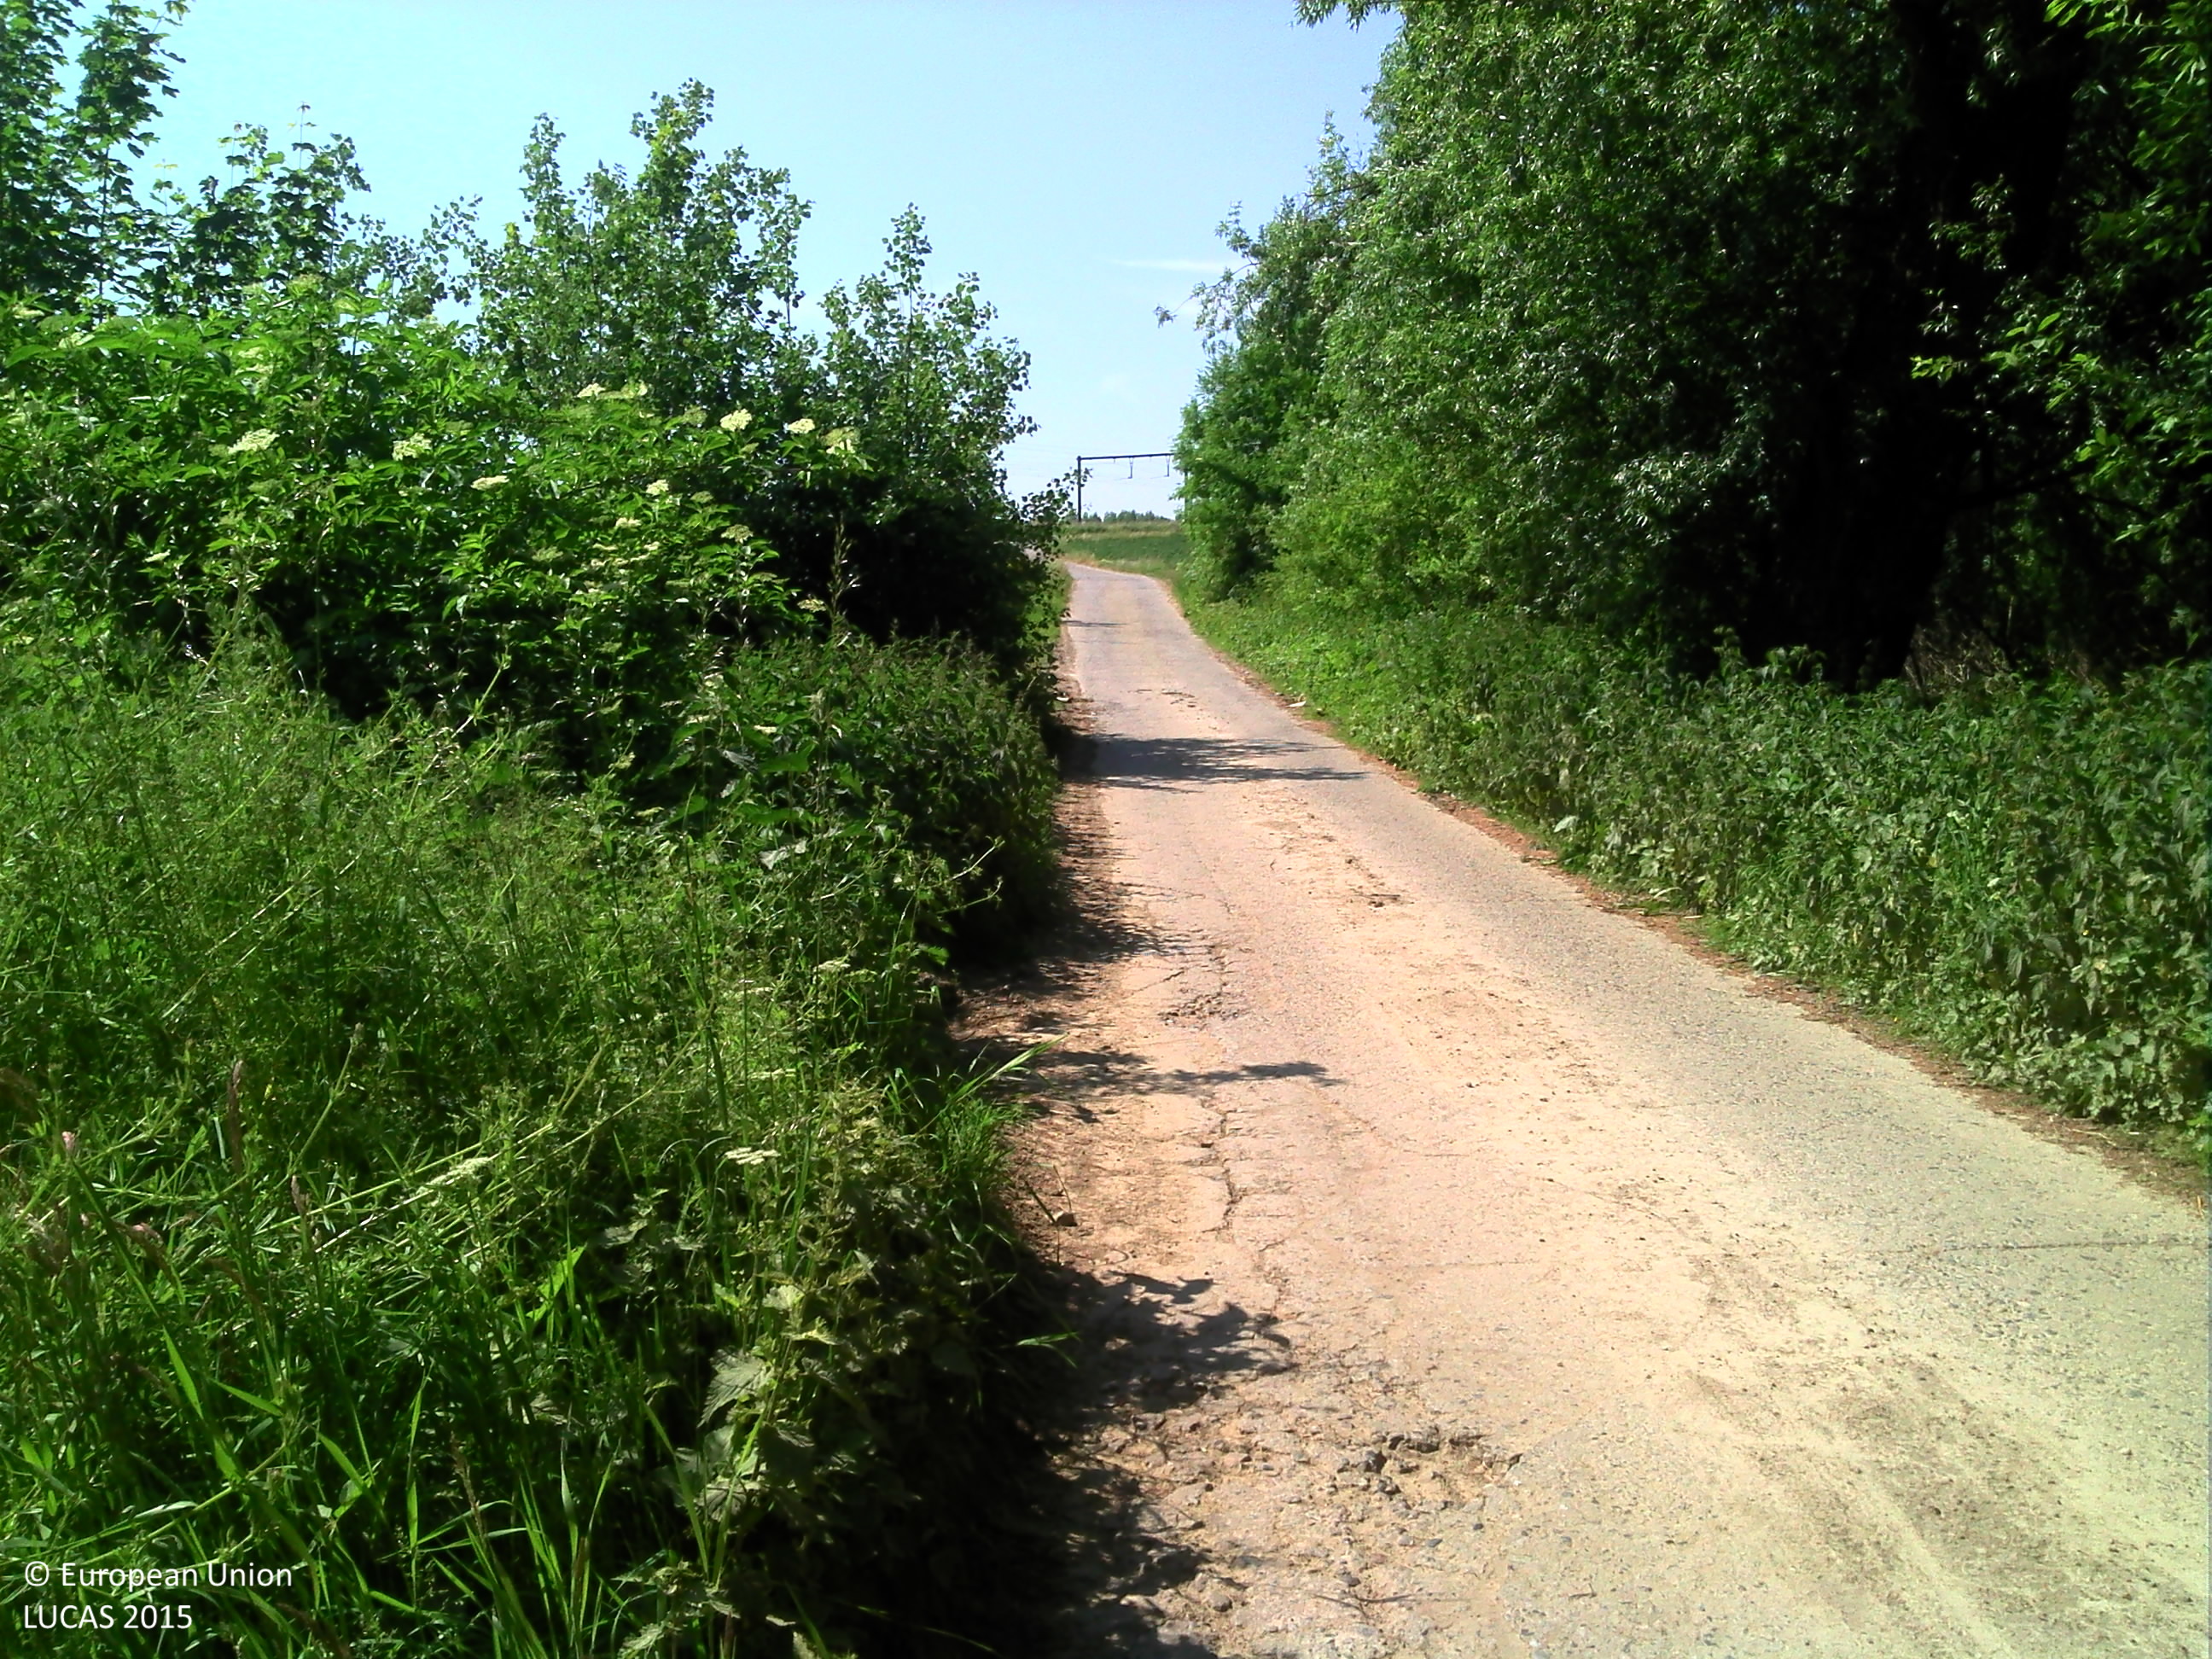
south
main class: Grassland
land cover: Spontaneously vegetated surfaces
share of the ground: > 75 %
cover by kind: herbaceous plants 100 %
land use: Semi-natural and natural areas not in use
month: June
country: BE
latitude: 50.8158
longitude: 5.4988
